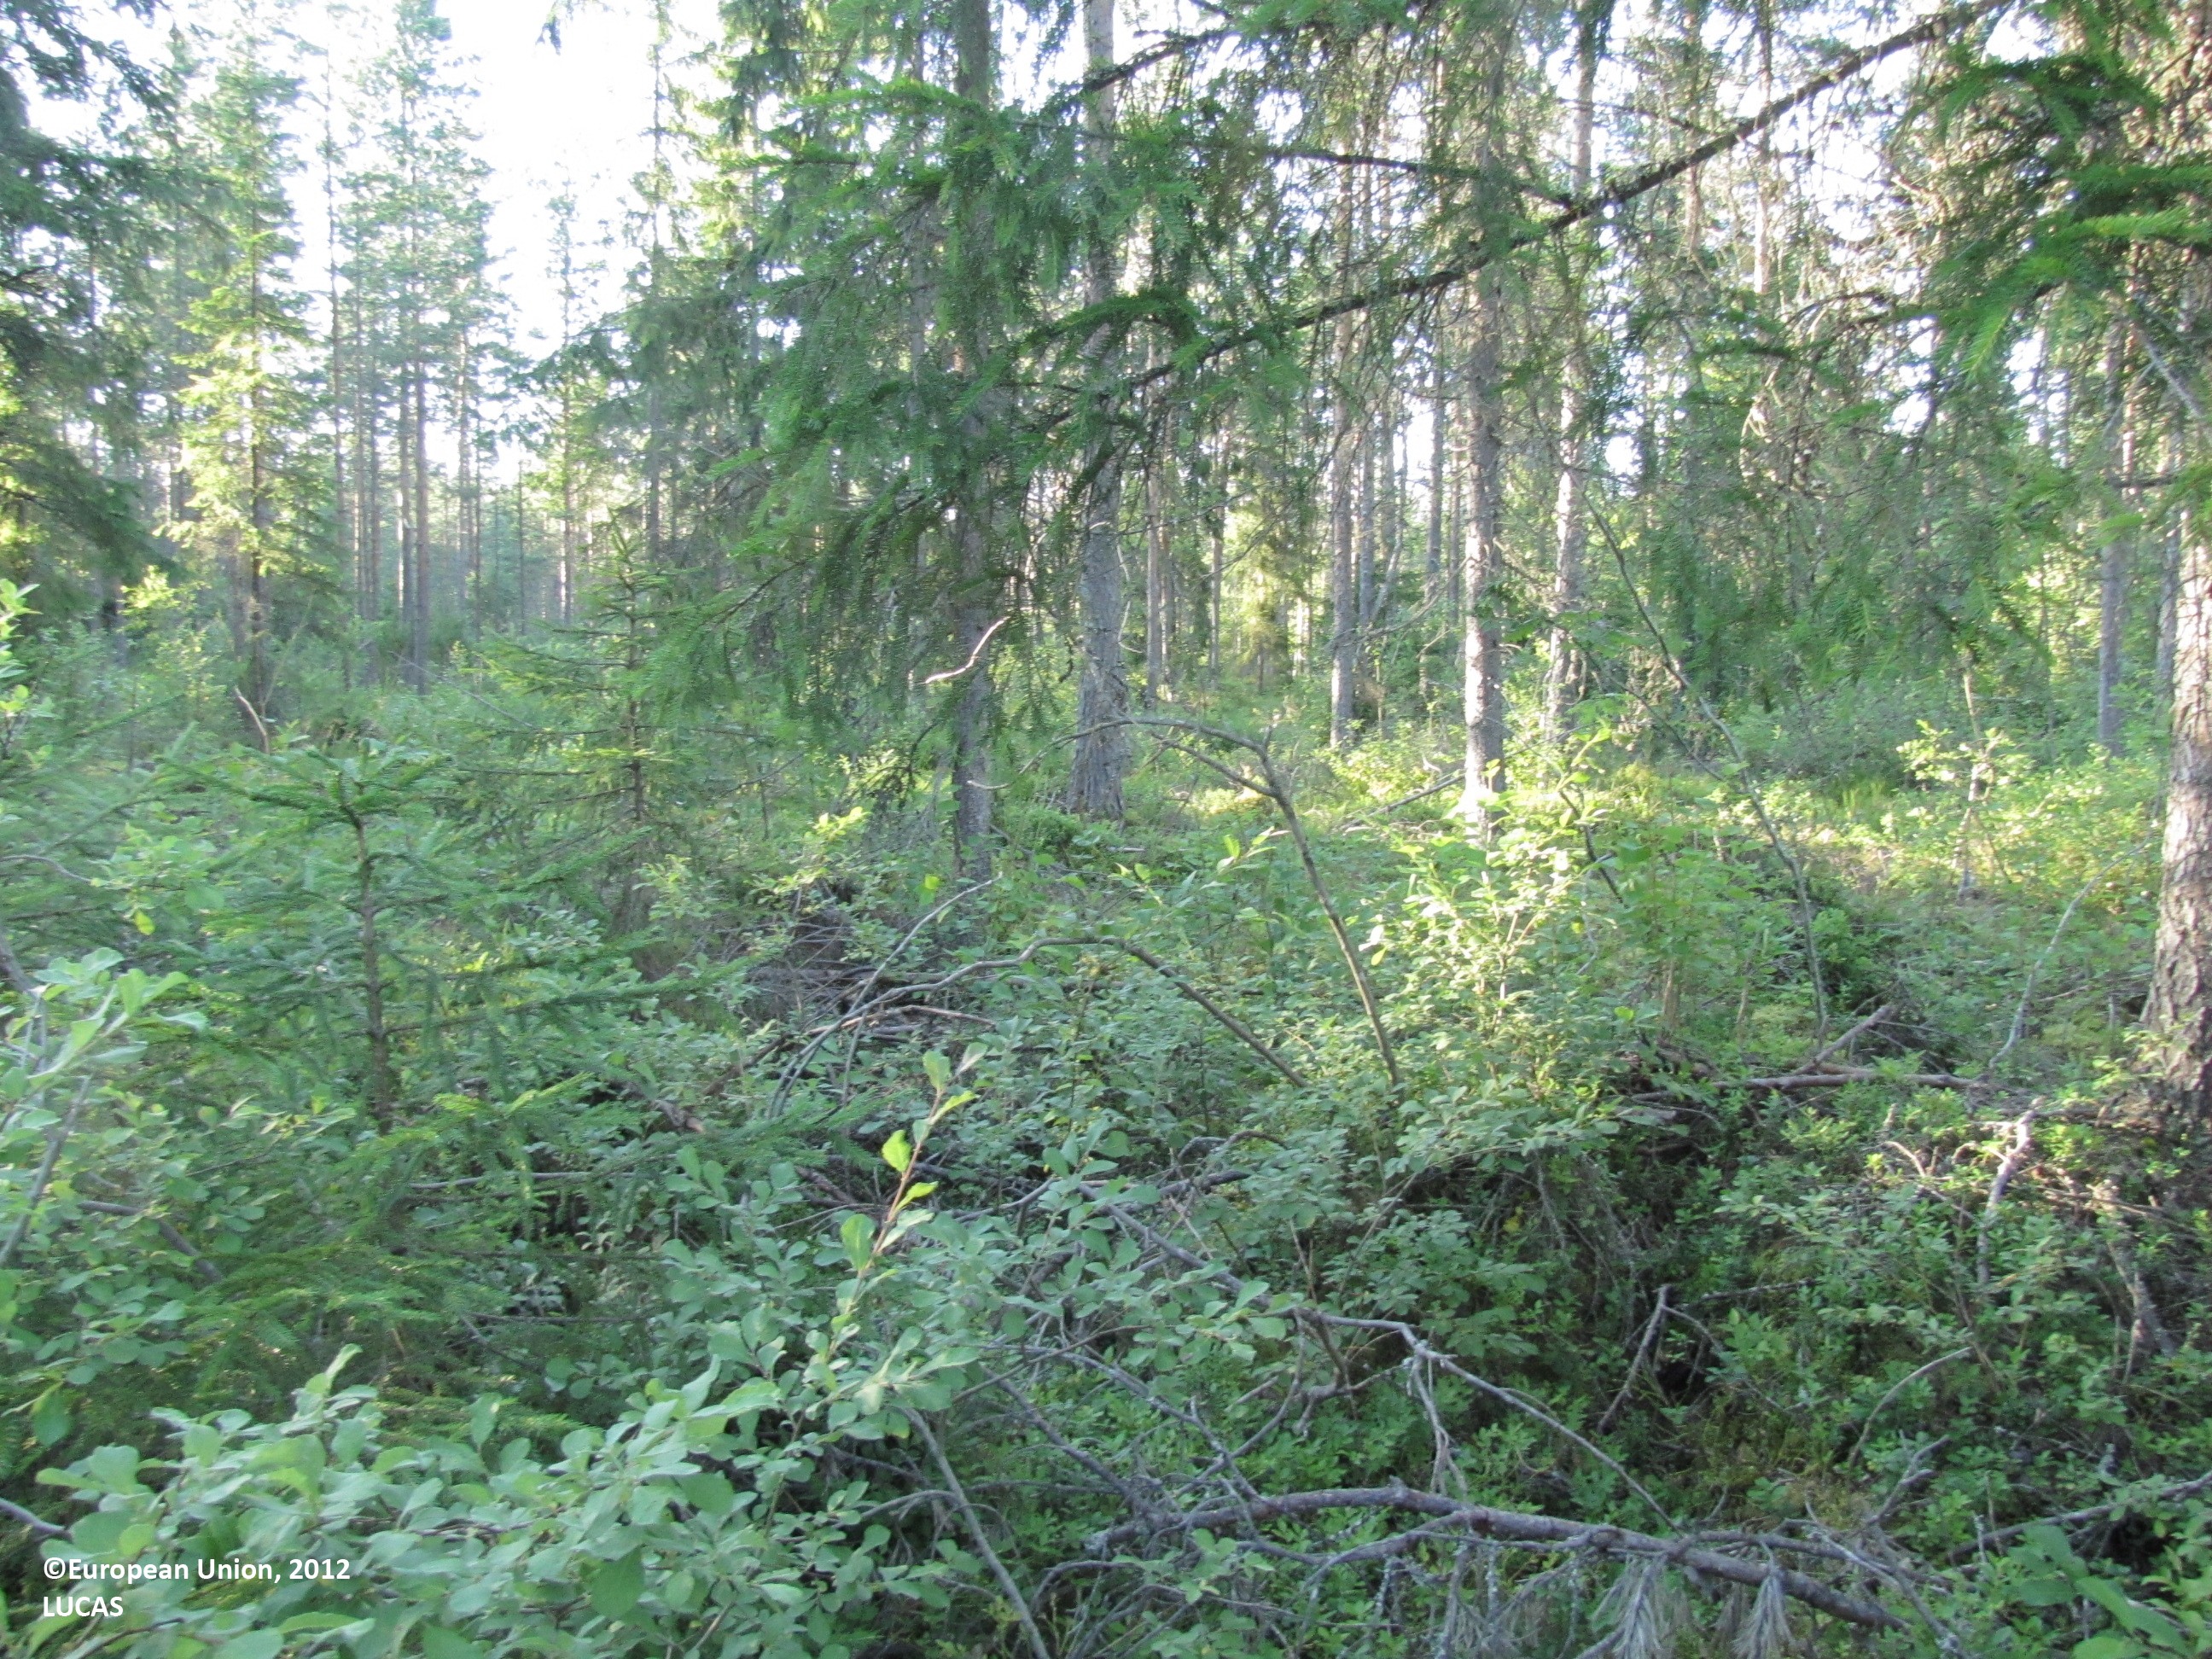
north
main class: Woodland
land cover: Pine dominated coniferous woodland
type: boreal forest
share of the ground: 50 - 75 %
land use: Forestry
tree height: > 5 m
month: July
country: FI
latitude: 62.1219
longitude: 22.9673
